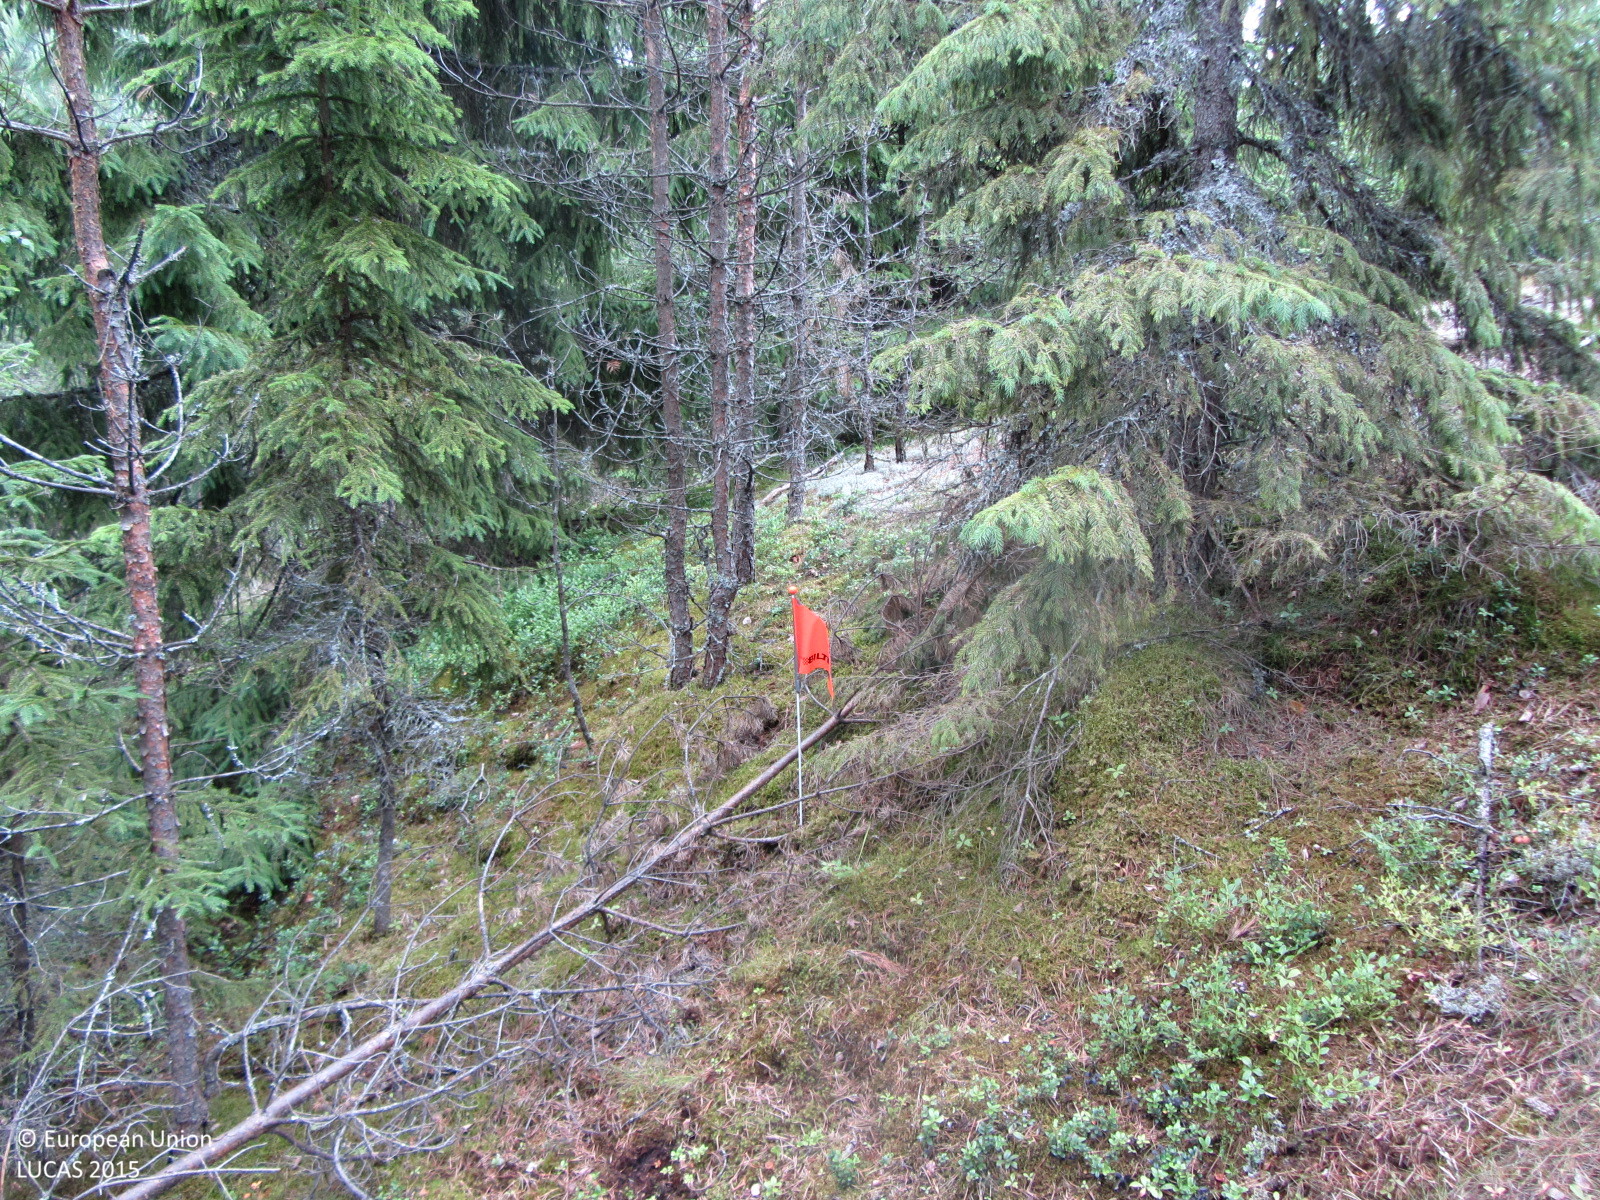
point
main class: Woodland
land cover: Other coniferous woodland
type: boreal forest
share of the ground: > 75 %
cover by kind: coniferous forest trees 80 %, shrubs 15 %, lichens and mosses 5 %
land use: Forestry
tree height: > 5 m
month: July
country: FI
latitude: 60.0232
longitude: 23.8587
